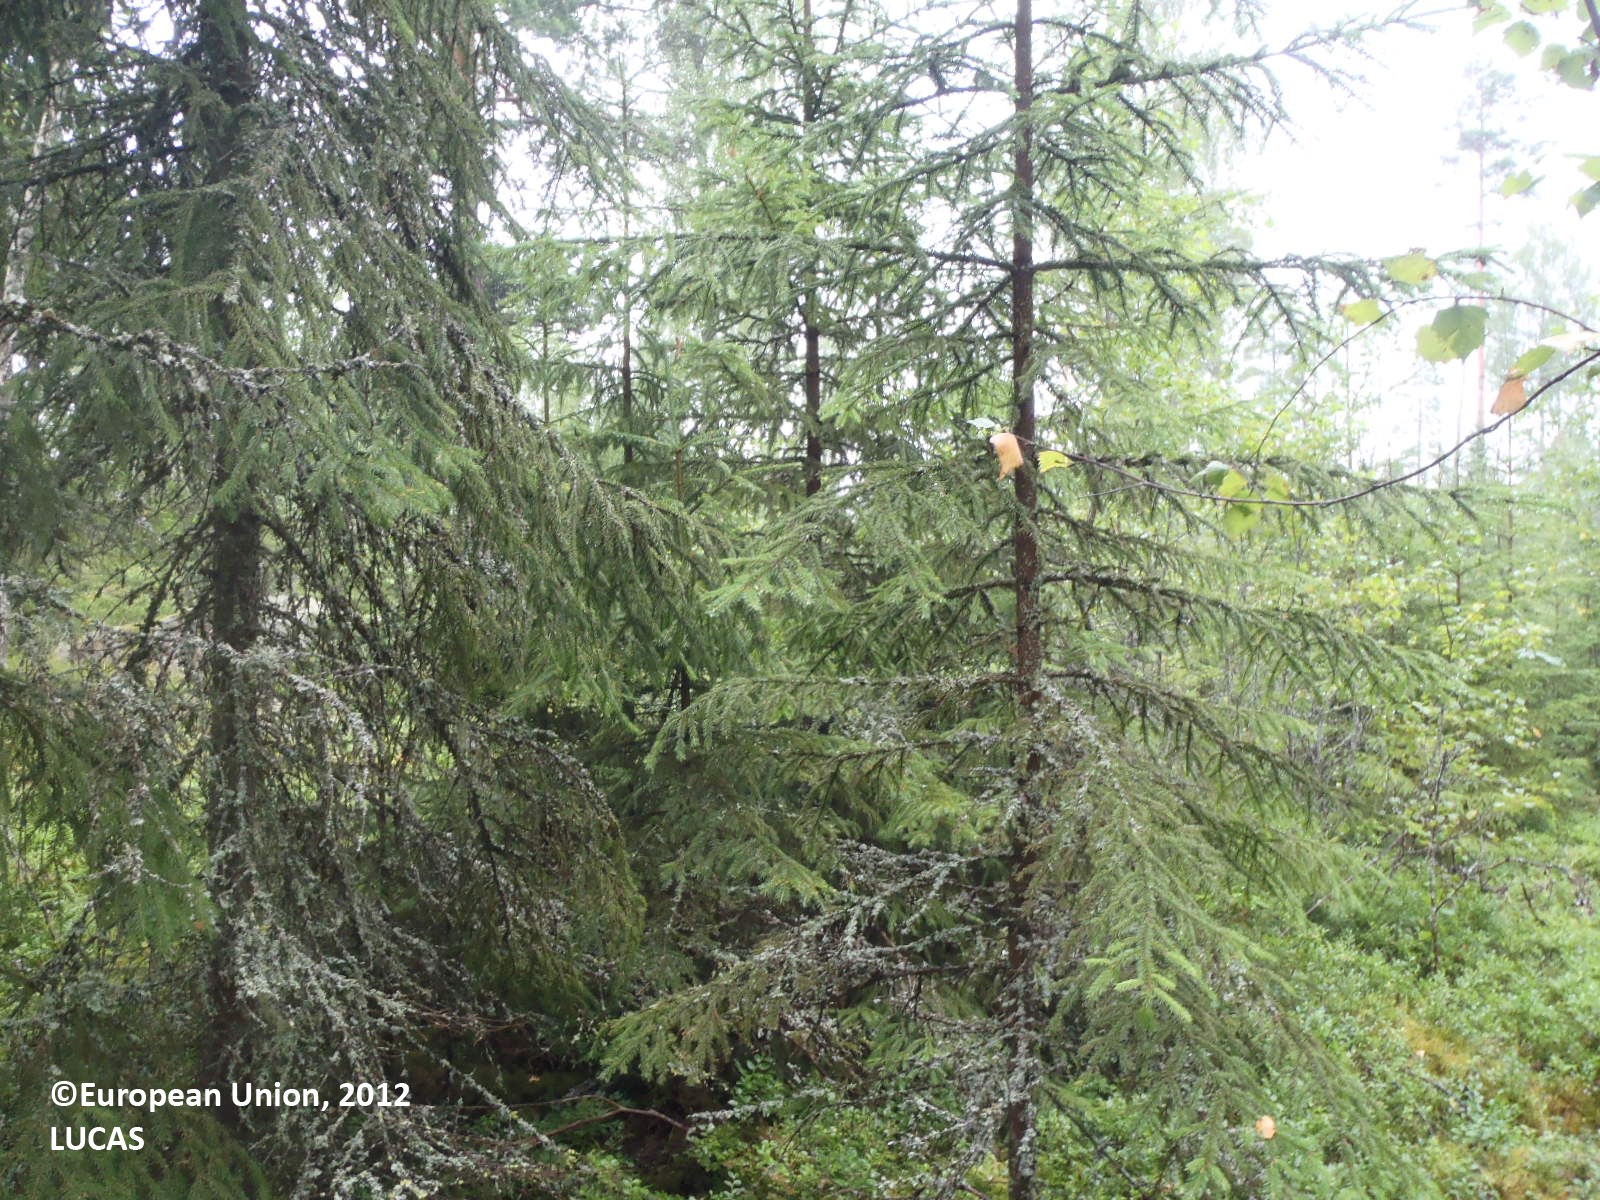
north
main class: Woodland
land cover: Spruce dominated mixed woodland
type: boreal forest
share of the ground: > 75 %
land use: Forestry
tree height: > 5 m
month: July
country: FI
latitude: 60.7457
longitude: 21.7437
